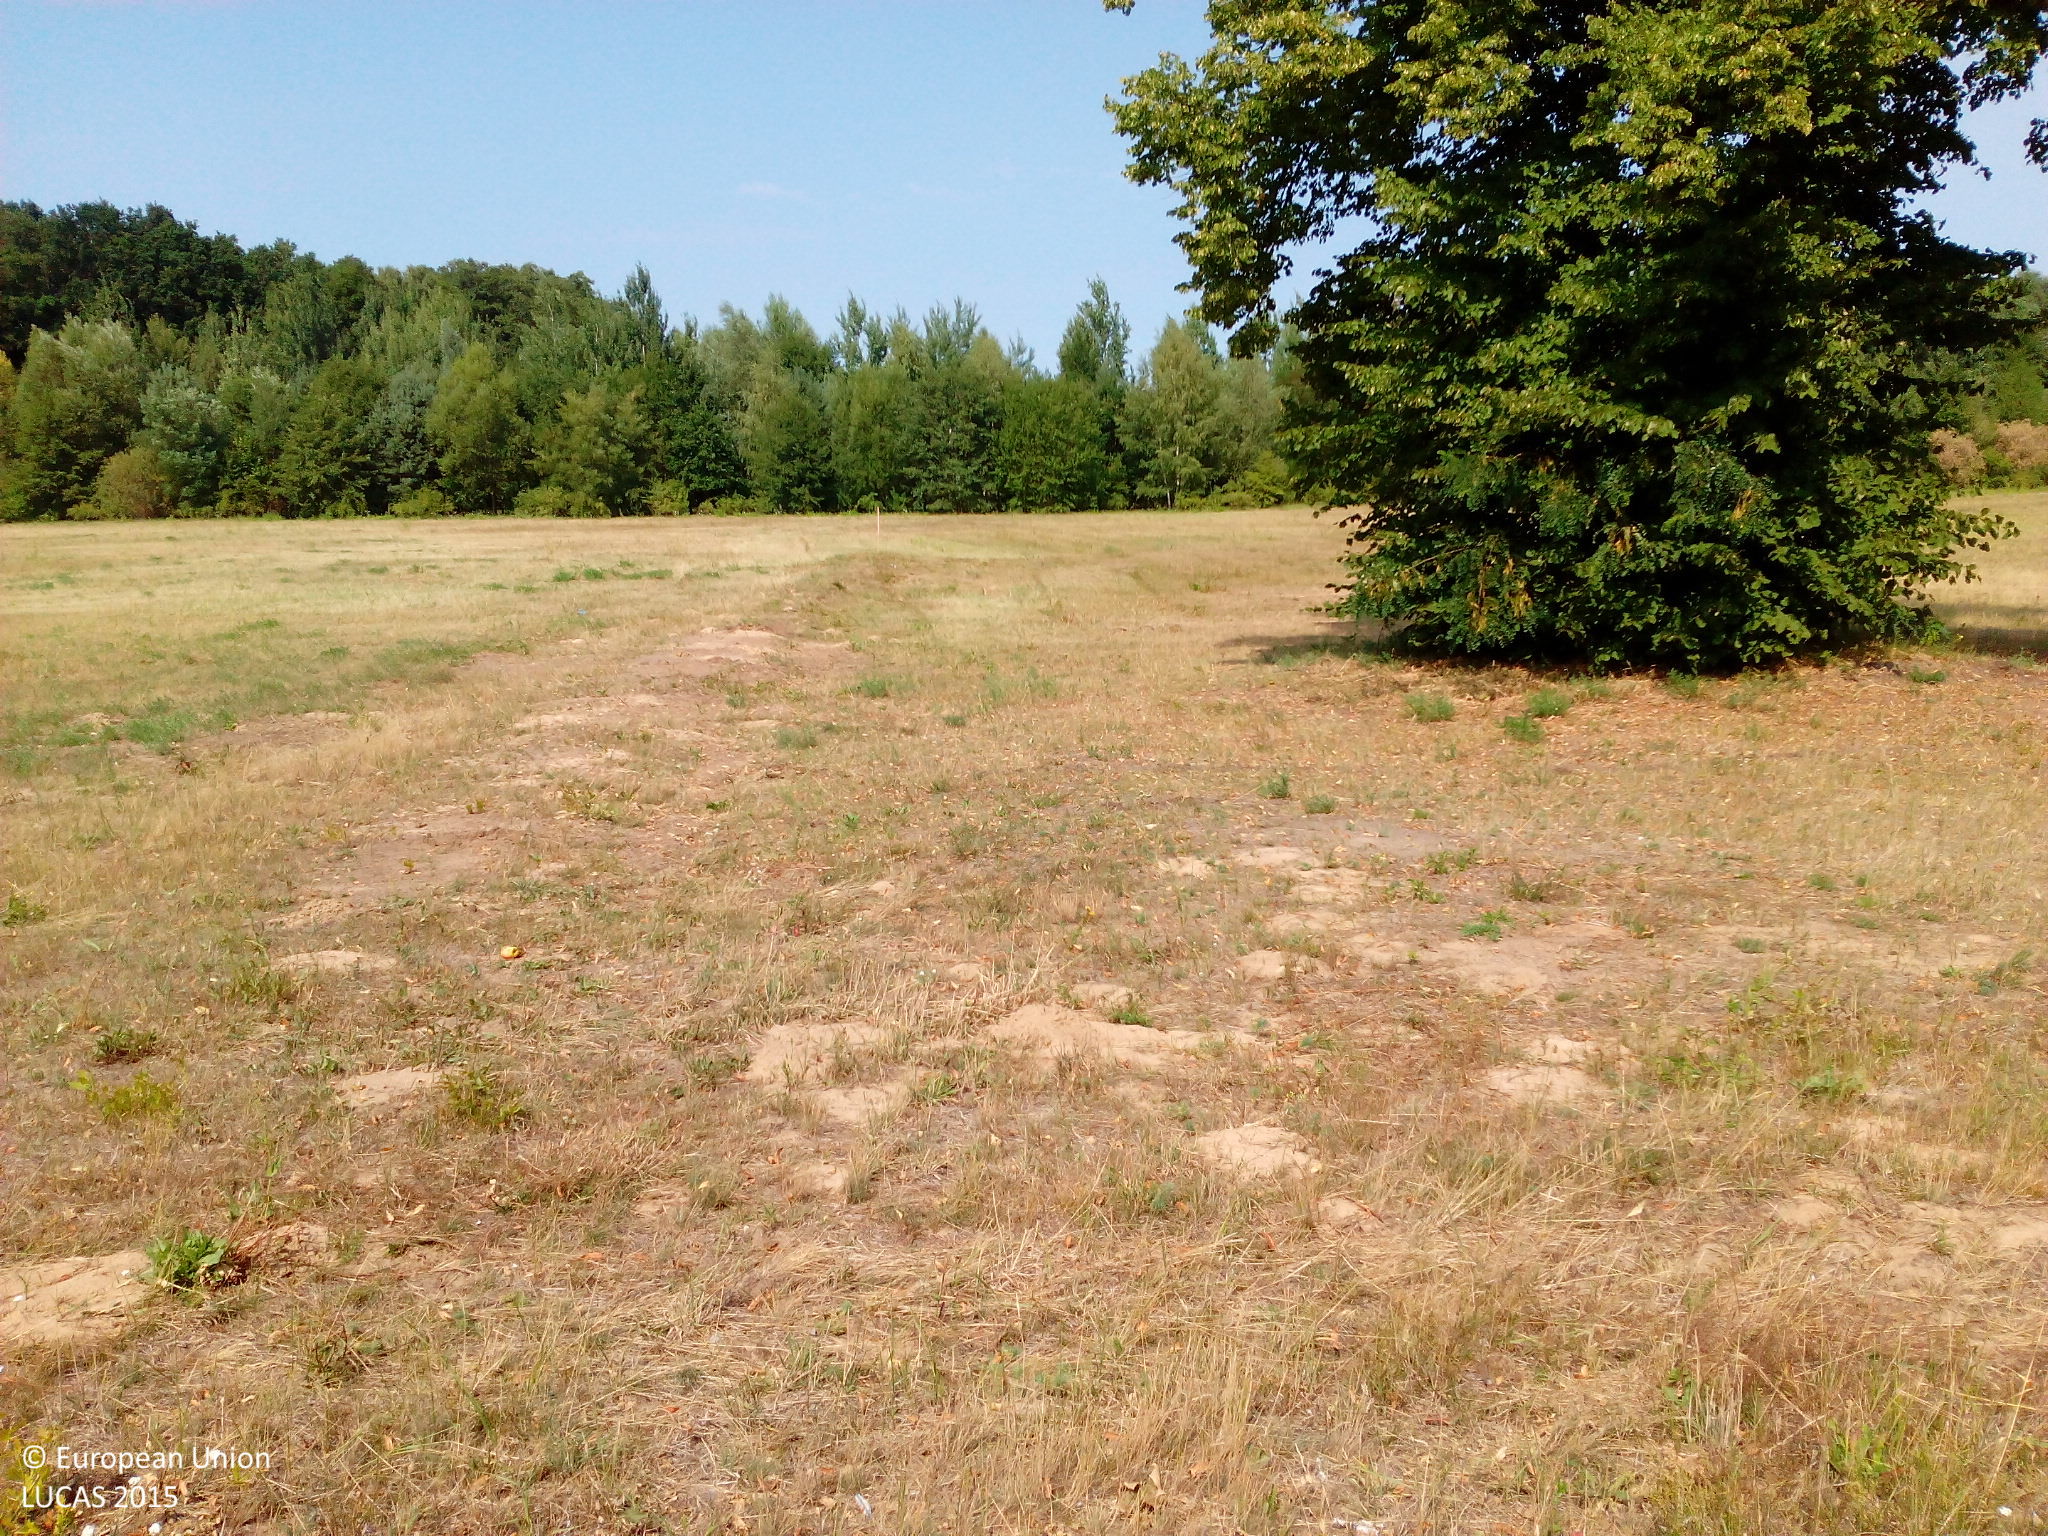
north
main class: Grassland
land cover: Grassland without tree/shrub cover
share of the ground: > 75 %
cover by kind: herbaceous plants 90 %, unconsolidated bare surface 10 %
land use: Machinery and equipment
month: August
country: DE
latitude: 52.6221
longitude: 13.2054
